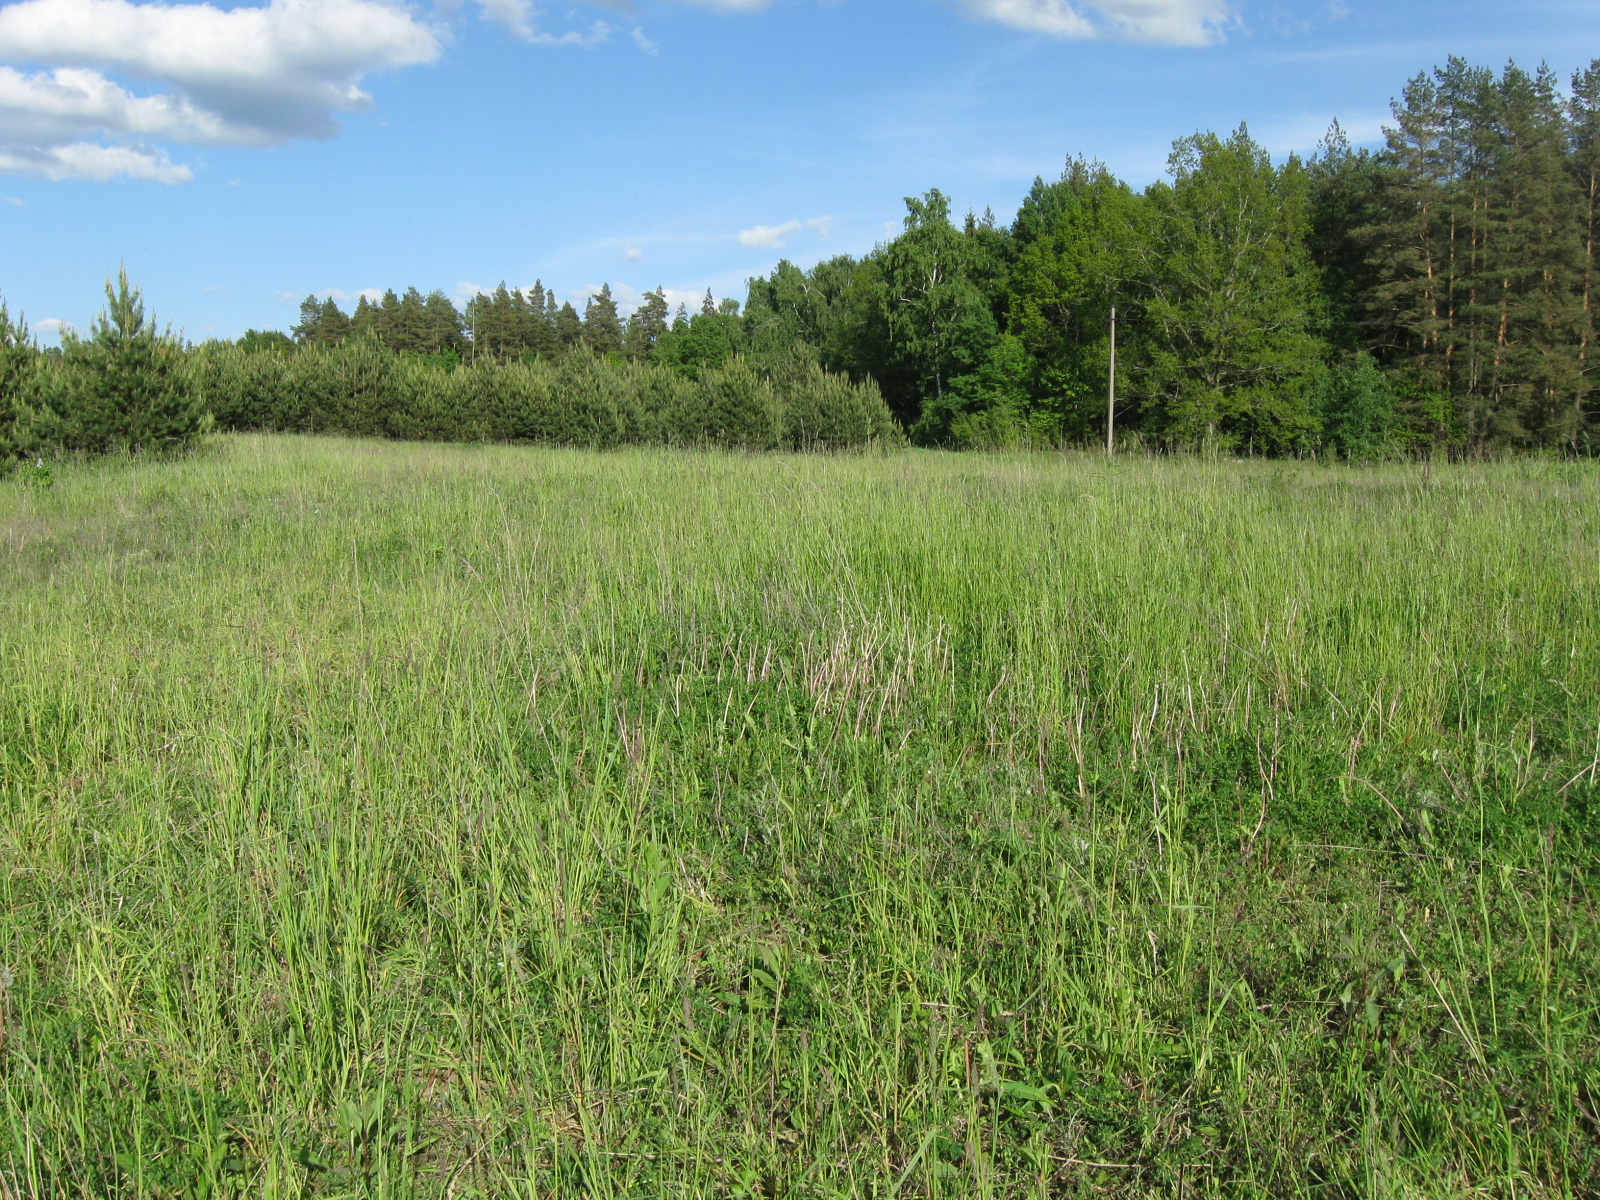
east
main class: Grassland
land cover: Grassland without tree/shrub cover
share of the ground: > 75 %
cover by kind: herbaceous plants 95 %, unconsolidated bare surface 5 %
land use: Agriculture (excluding fallow land and kitchen gardens)
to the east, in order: Grassland without tree/shrub cover; Grassland with sparse tree/shrub cover; Tracks; Pine dominated coniferous woodland; Oats; Other leguminous and mixtures for fodder; Pine dominated coniferous woodland; Electric lines; Oats; Tracks; Grassland with sparse tree/shrub cover
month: May
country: LT
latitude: 54.2943
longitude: 23.4013
